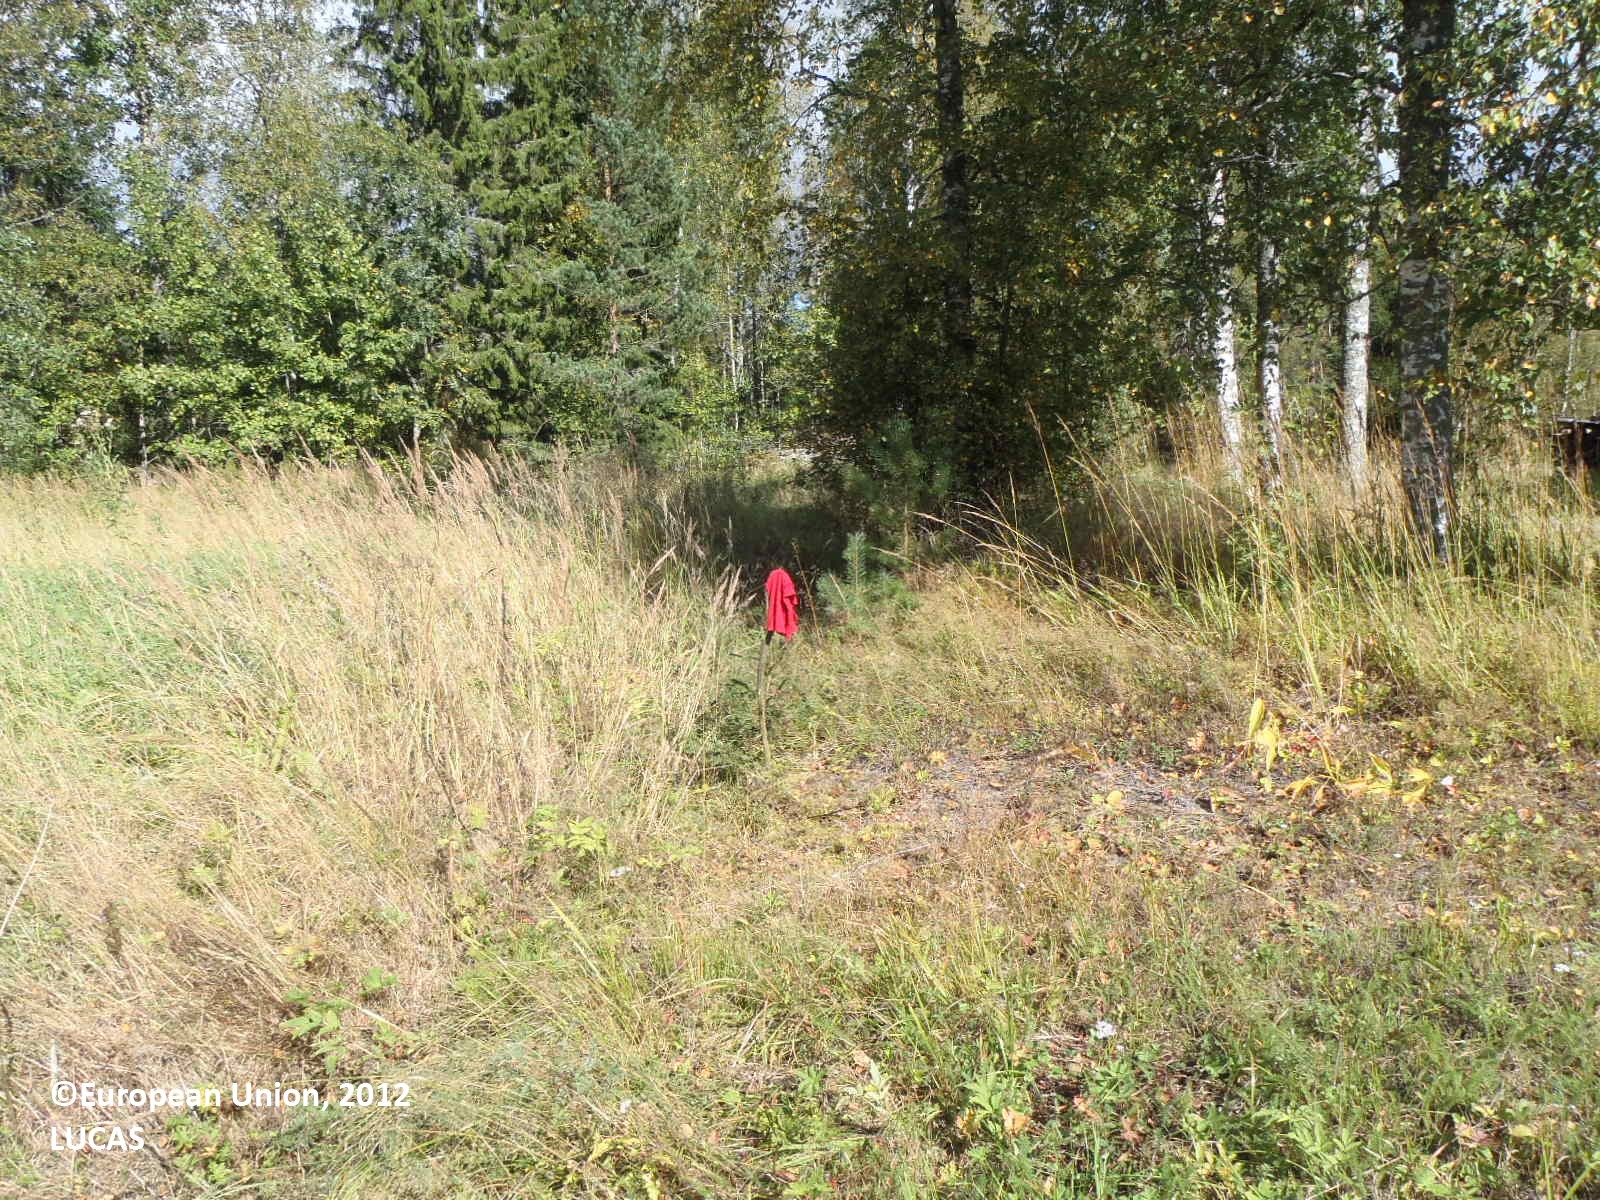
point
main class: Grassland
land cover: Grassland without tree/shrub cover
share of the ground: > 75 %
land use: Residential
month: September
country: FI
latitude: 61.3591
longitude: 22.6913
